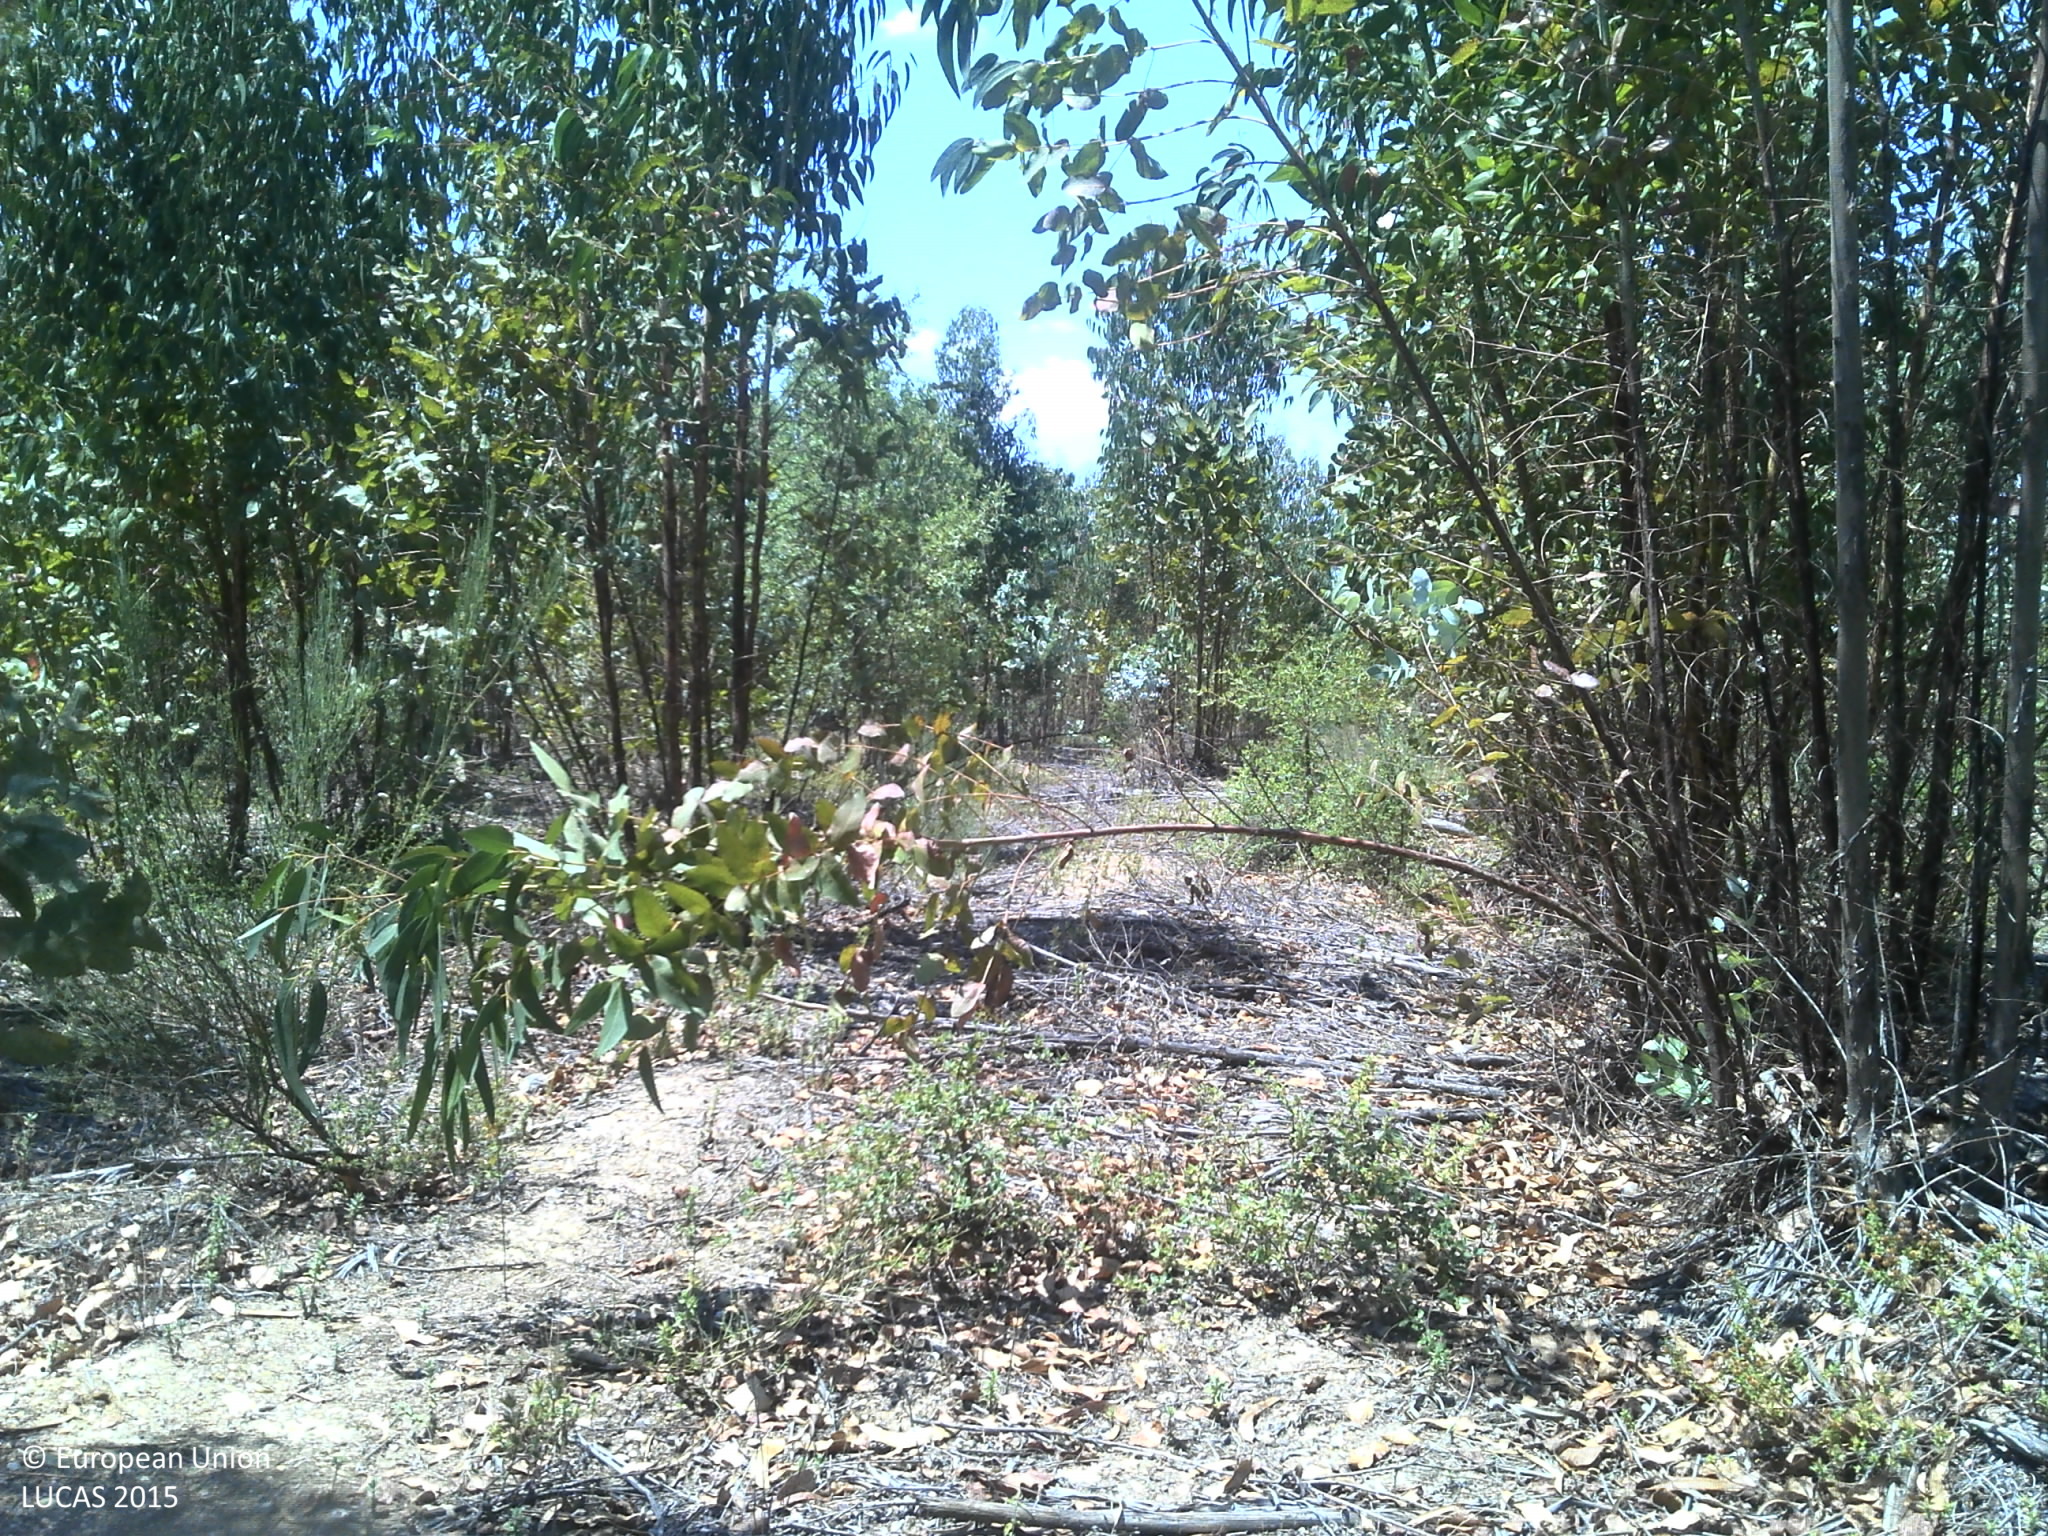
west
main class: Woodland
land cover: Broadleaved woodland
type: exotic forest
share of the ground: 50 - 75 %
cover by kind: broadleaved forest trees 75 %, shrubs 15 %, unconsolidated bare surface 10 %
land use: Forestry
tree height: > 5 m
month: June
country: PT
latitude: 39.2878
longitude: -8.3001
